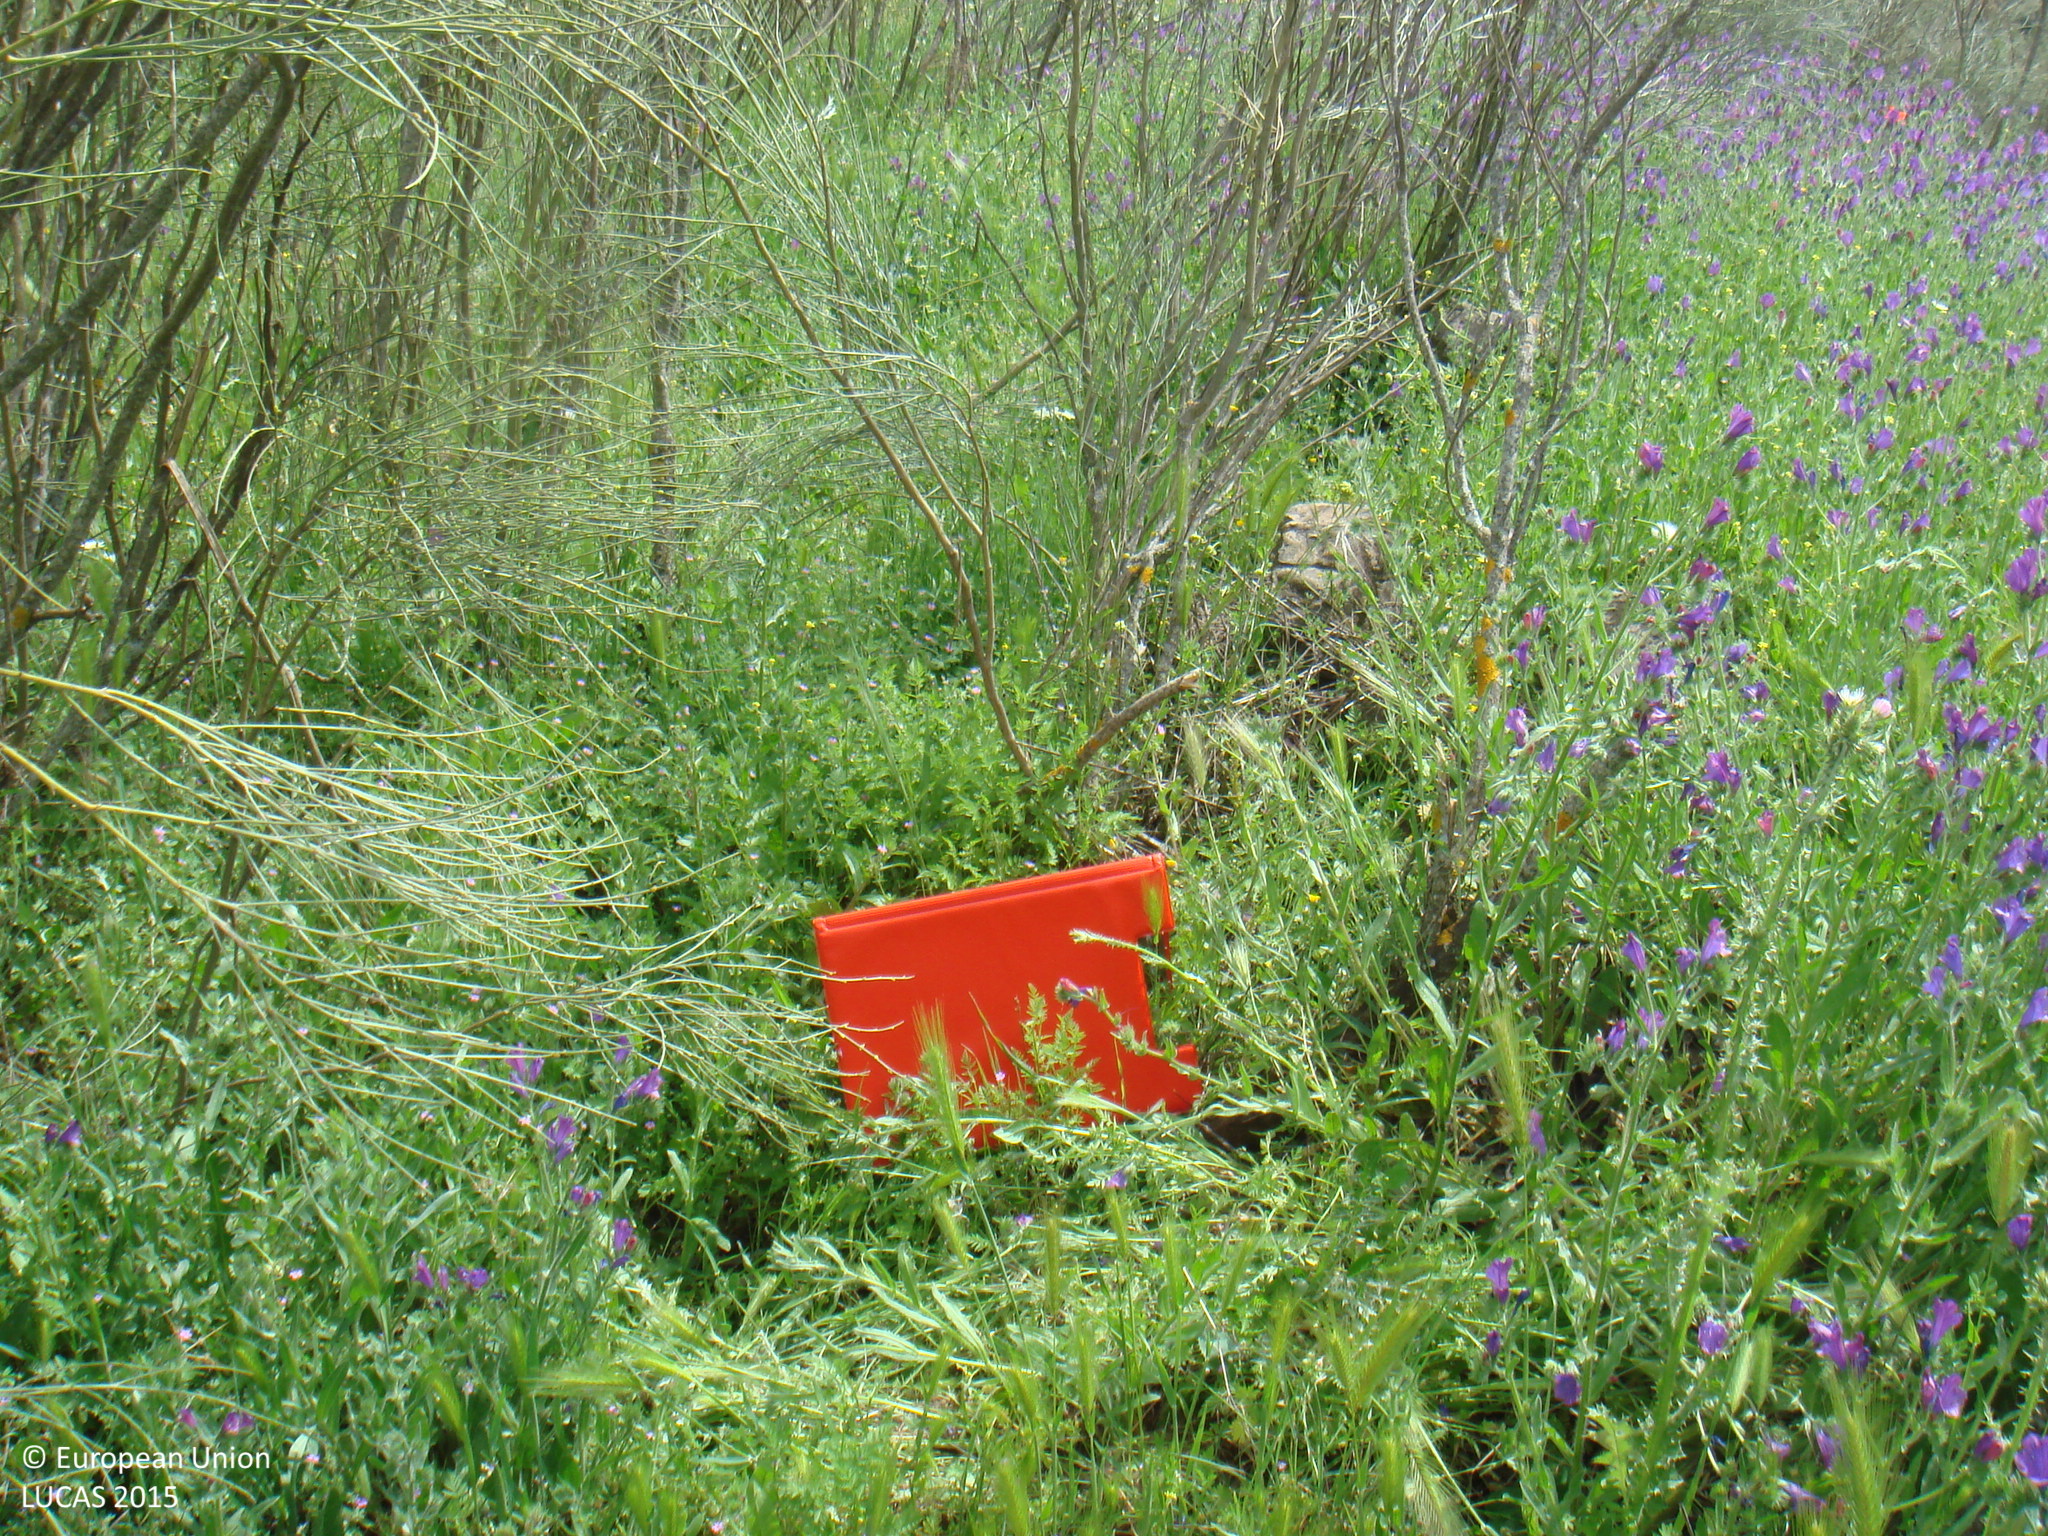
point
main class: Shrubland
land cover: Shrubland with sparse tree cover
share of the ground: 25 - 50 %
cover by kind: herbaceous plants 55 %, shrubs 40 %, broadleaved forest trees 5 %
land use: Semi-natural and natural areas not in use
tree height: > 5 m
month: April
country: ES
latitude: 38.2178
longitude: -5.0434
